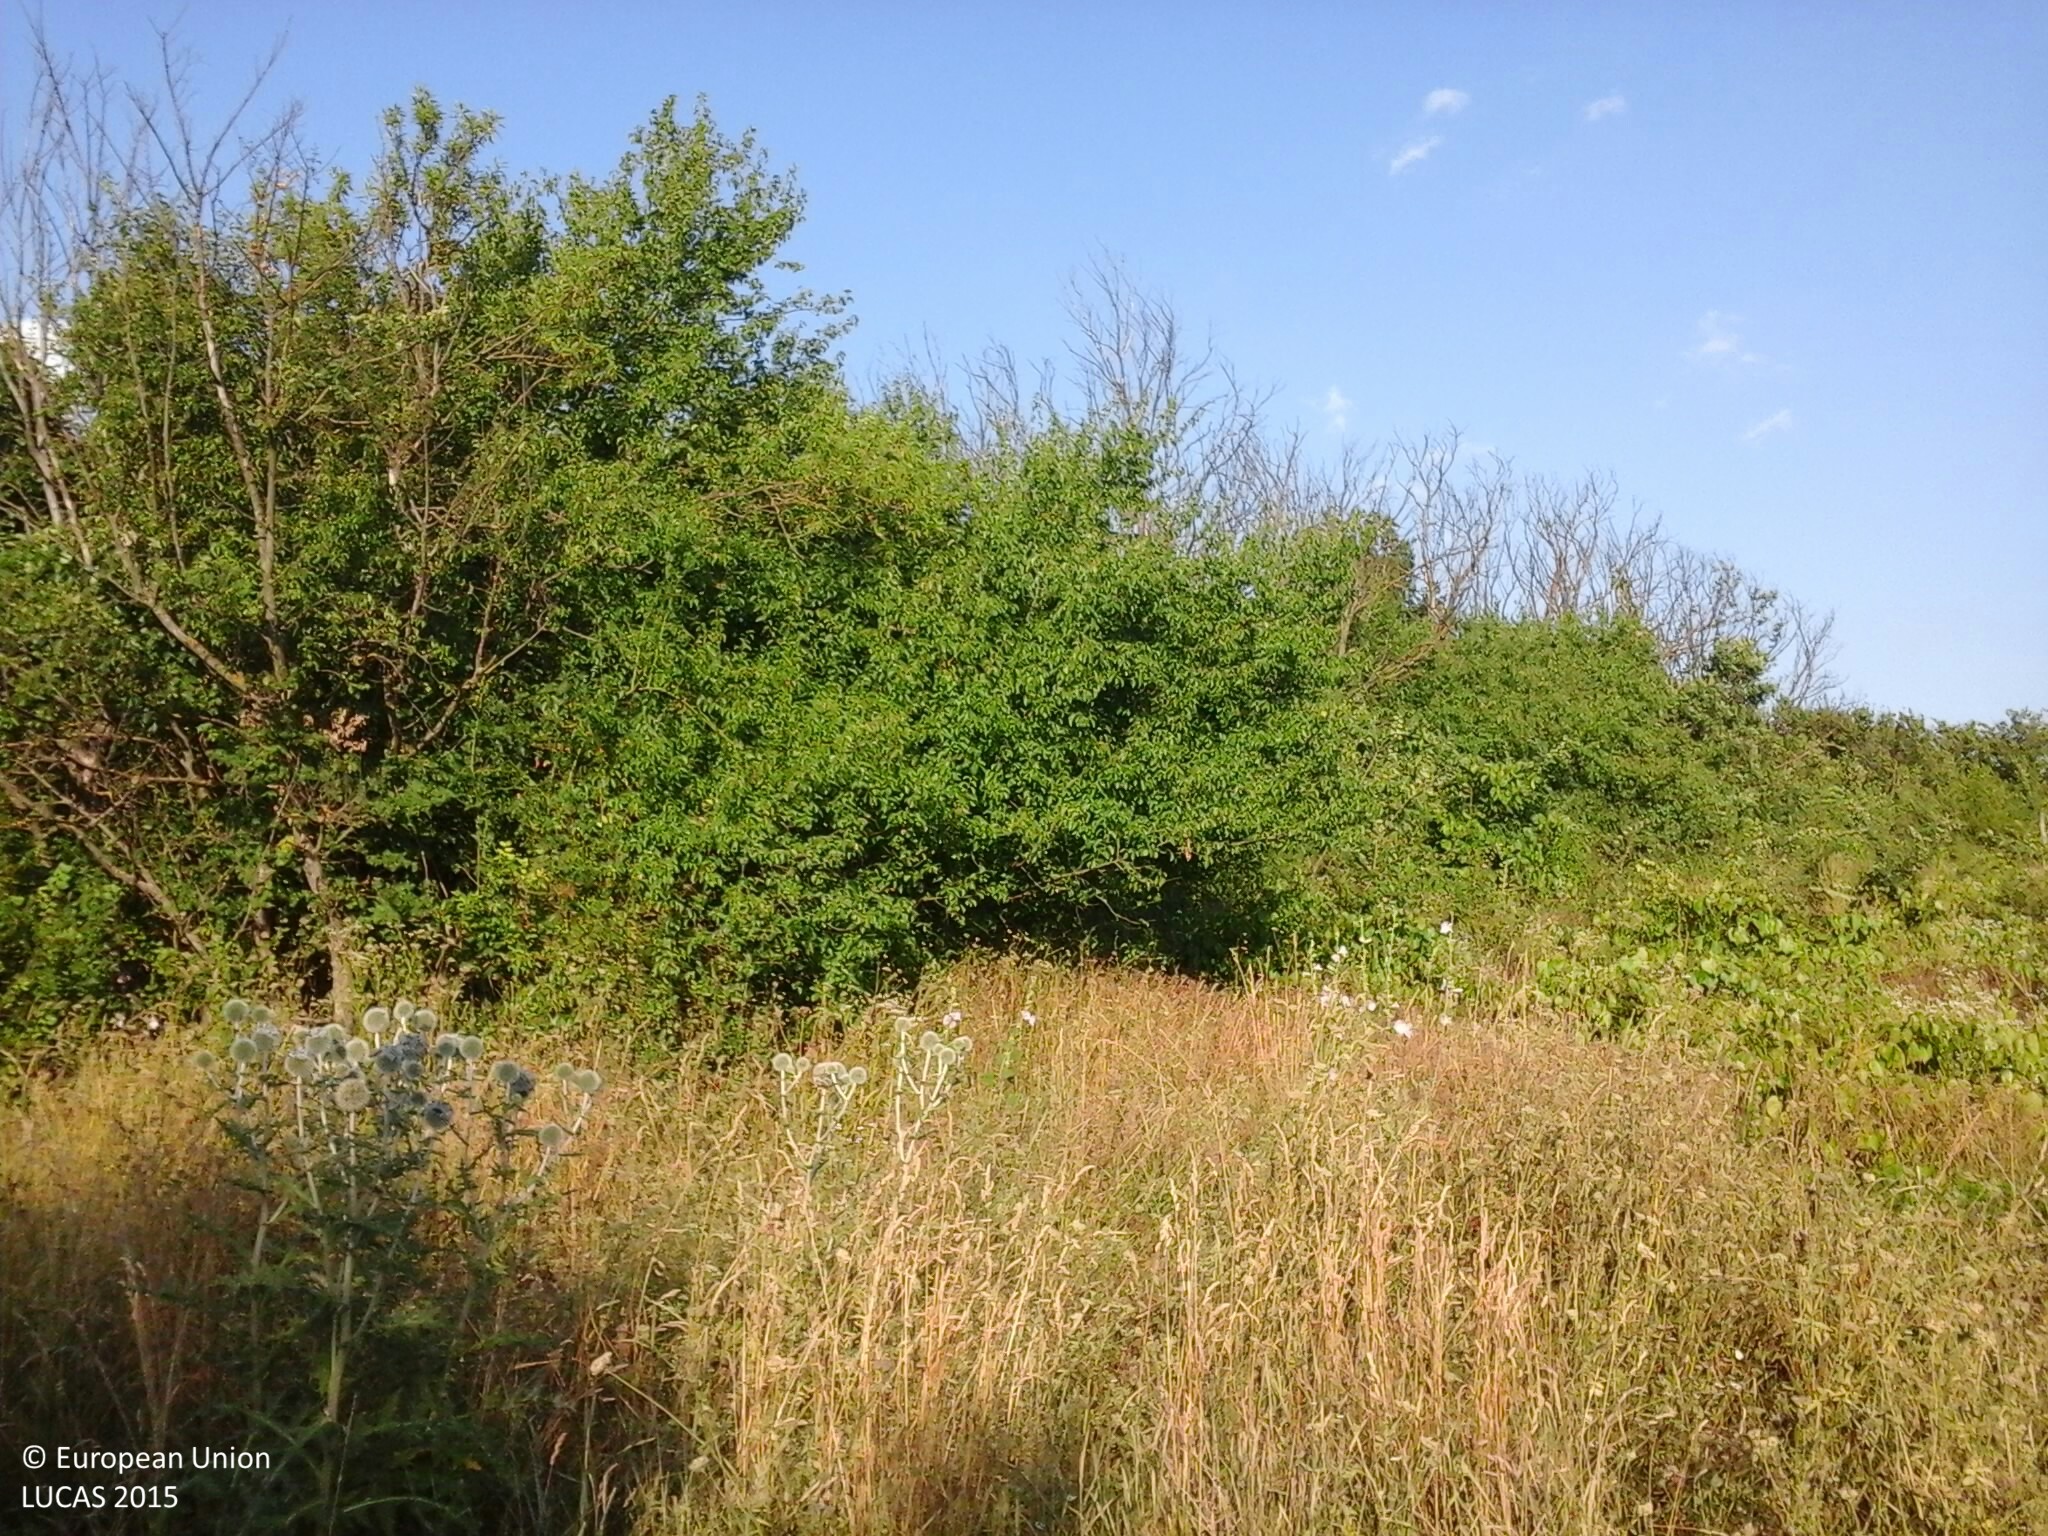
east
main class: Cropland
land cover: Vineyards
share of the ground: 50 - 75 %
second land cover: Grassland without tree/shrub cover
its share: 25 - 50 %
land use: Agriculture (excluding fallow land and kitchen gardens)
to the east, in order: Vineyards; Grassland without tree/shrub cover; Broadleaved woodland; Tracks; Fences; Grassland without tree/shrub cover; Vineyards; Broadleaved woodland; Grassland without tree/shrub cover; Broadleaved woodland
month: July
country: HU
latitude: 46.9110
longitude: 17.8726
